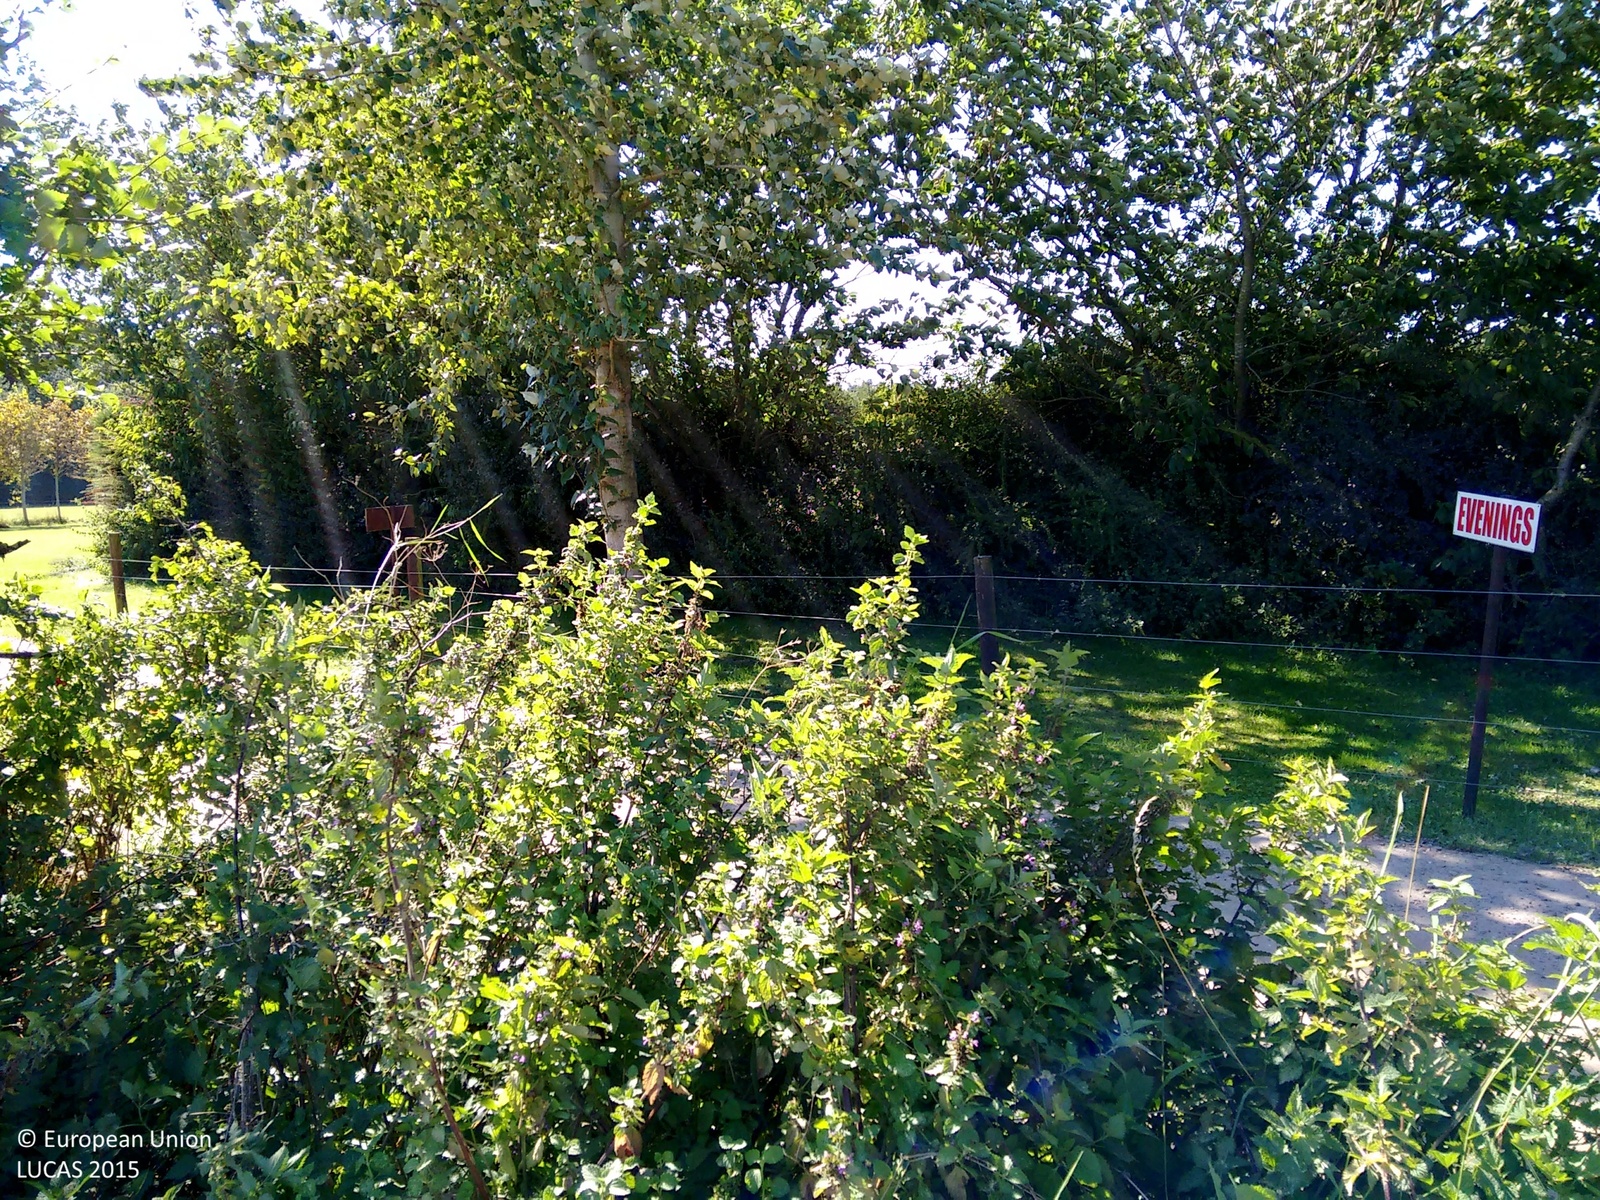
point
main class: Grassland
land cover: Grassland with sparse tree/shrub cover
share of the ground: > 75 %
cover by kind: herbaceous plants 95 %, broadleaved forest trees 5 %
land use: Amenities, museums, leisure
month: September
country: GB
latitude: 52.4946
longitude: 0.8585
